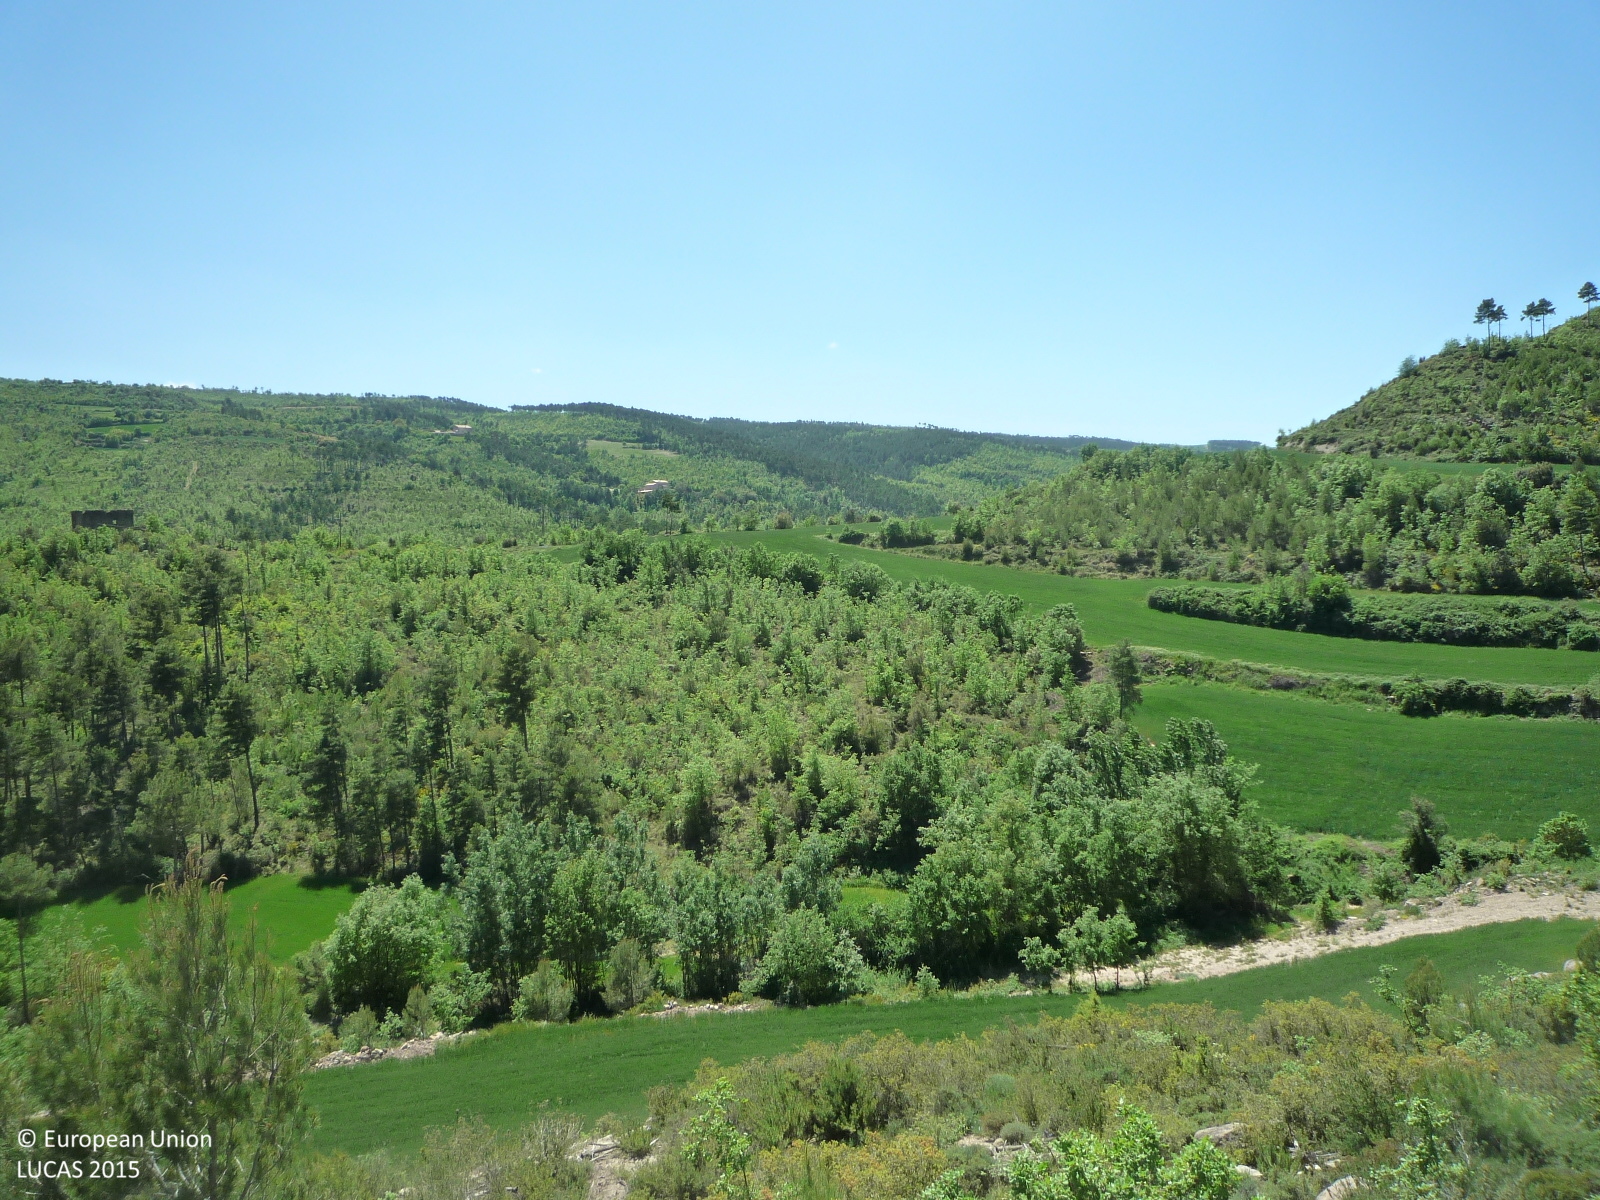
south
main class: Shrubland
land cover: Shrubland with sparse tree cover
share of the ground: > 75 %
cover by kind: shrubs 95 %, coniferous forest trees 5 %
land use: Semi-natural and natural areas not in use
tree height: < 5 m
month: May
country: ES
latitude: 41.8165
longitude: 1.6234
